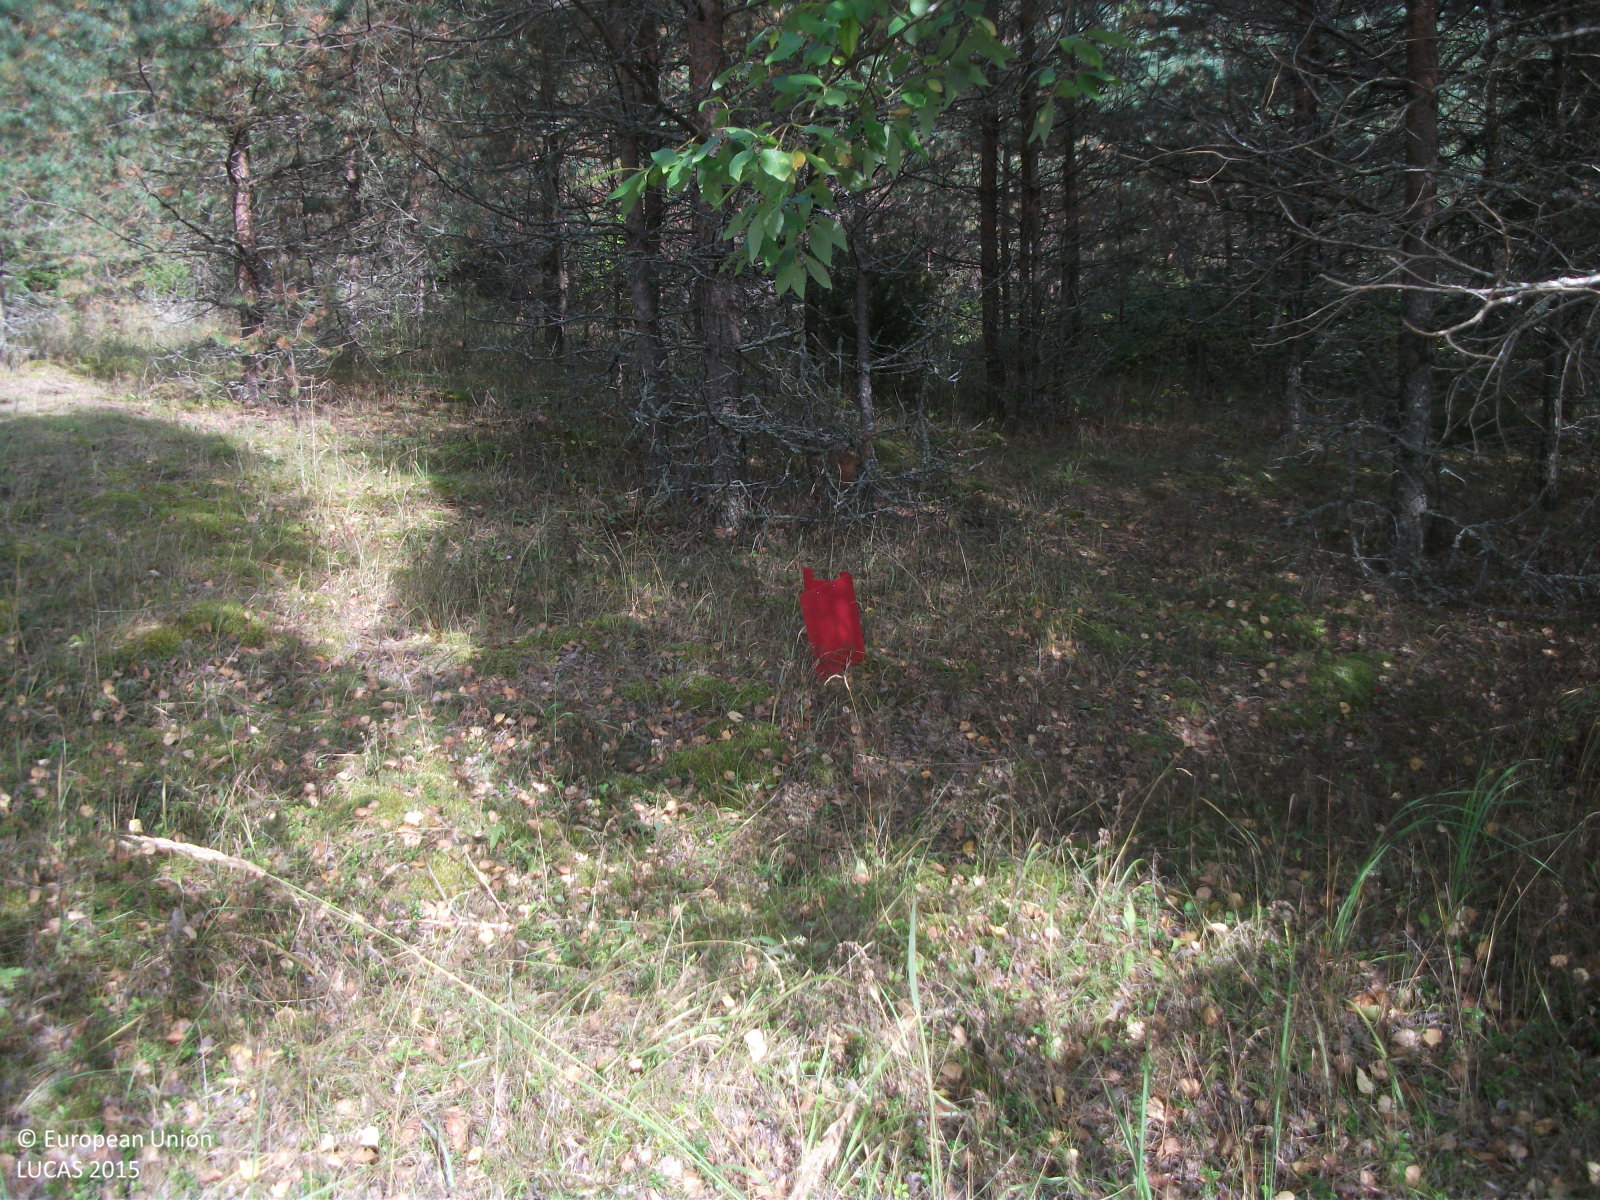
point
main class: Woodland
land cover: Pine dominated coniferous woodland
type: hemiboreal forest and nemoral coniferous forest and mixed broadleaved-coniferous forest
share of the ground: 50 - 75 %
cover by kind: coniferous forest trees 70 %, lichens and mosses 25 %, herbaceous plants 5 %
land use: Forestry
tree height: > 5 m
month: September
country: LV
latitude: 56.5760
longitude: 26.1047
